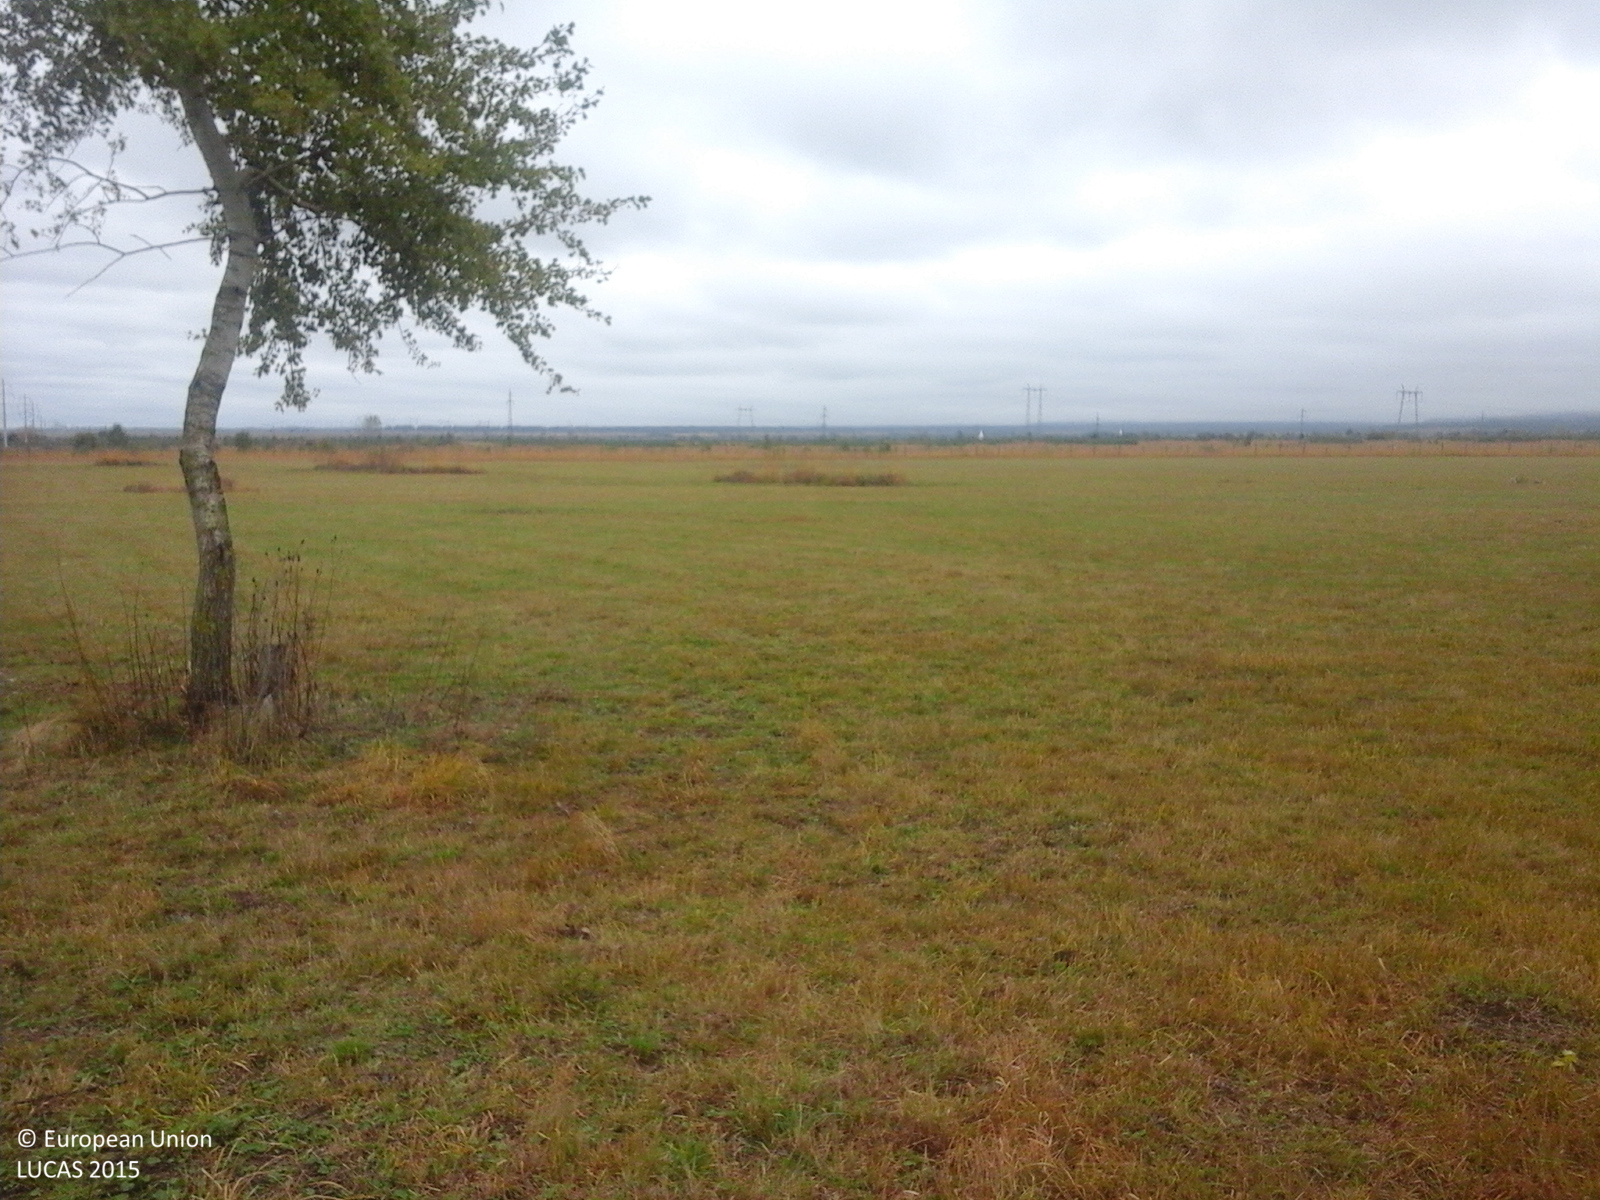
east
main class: Grassland
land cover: Grassland without tree/shrub cover
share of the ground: > 75 %
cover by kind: herbaceous plants 100 %
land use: Agriculture (excluding fallow land and kitchen gardens)
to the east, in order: Grassland without tree/shrub cover; Single bushes/trees; Grassland without tree/shrub cover; Fences; Grassland with sparse tree/shrub cover; Spontaneously vegetated surfaces; Ditches and canals; Spontaneously vegetated surfaces
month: October
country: RO
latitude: 45.7459
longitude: 24.5951
